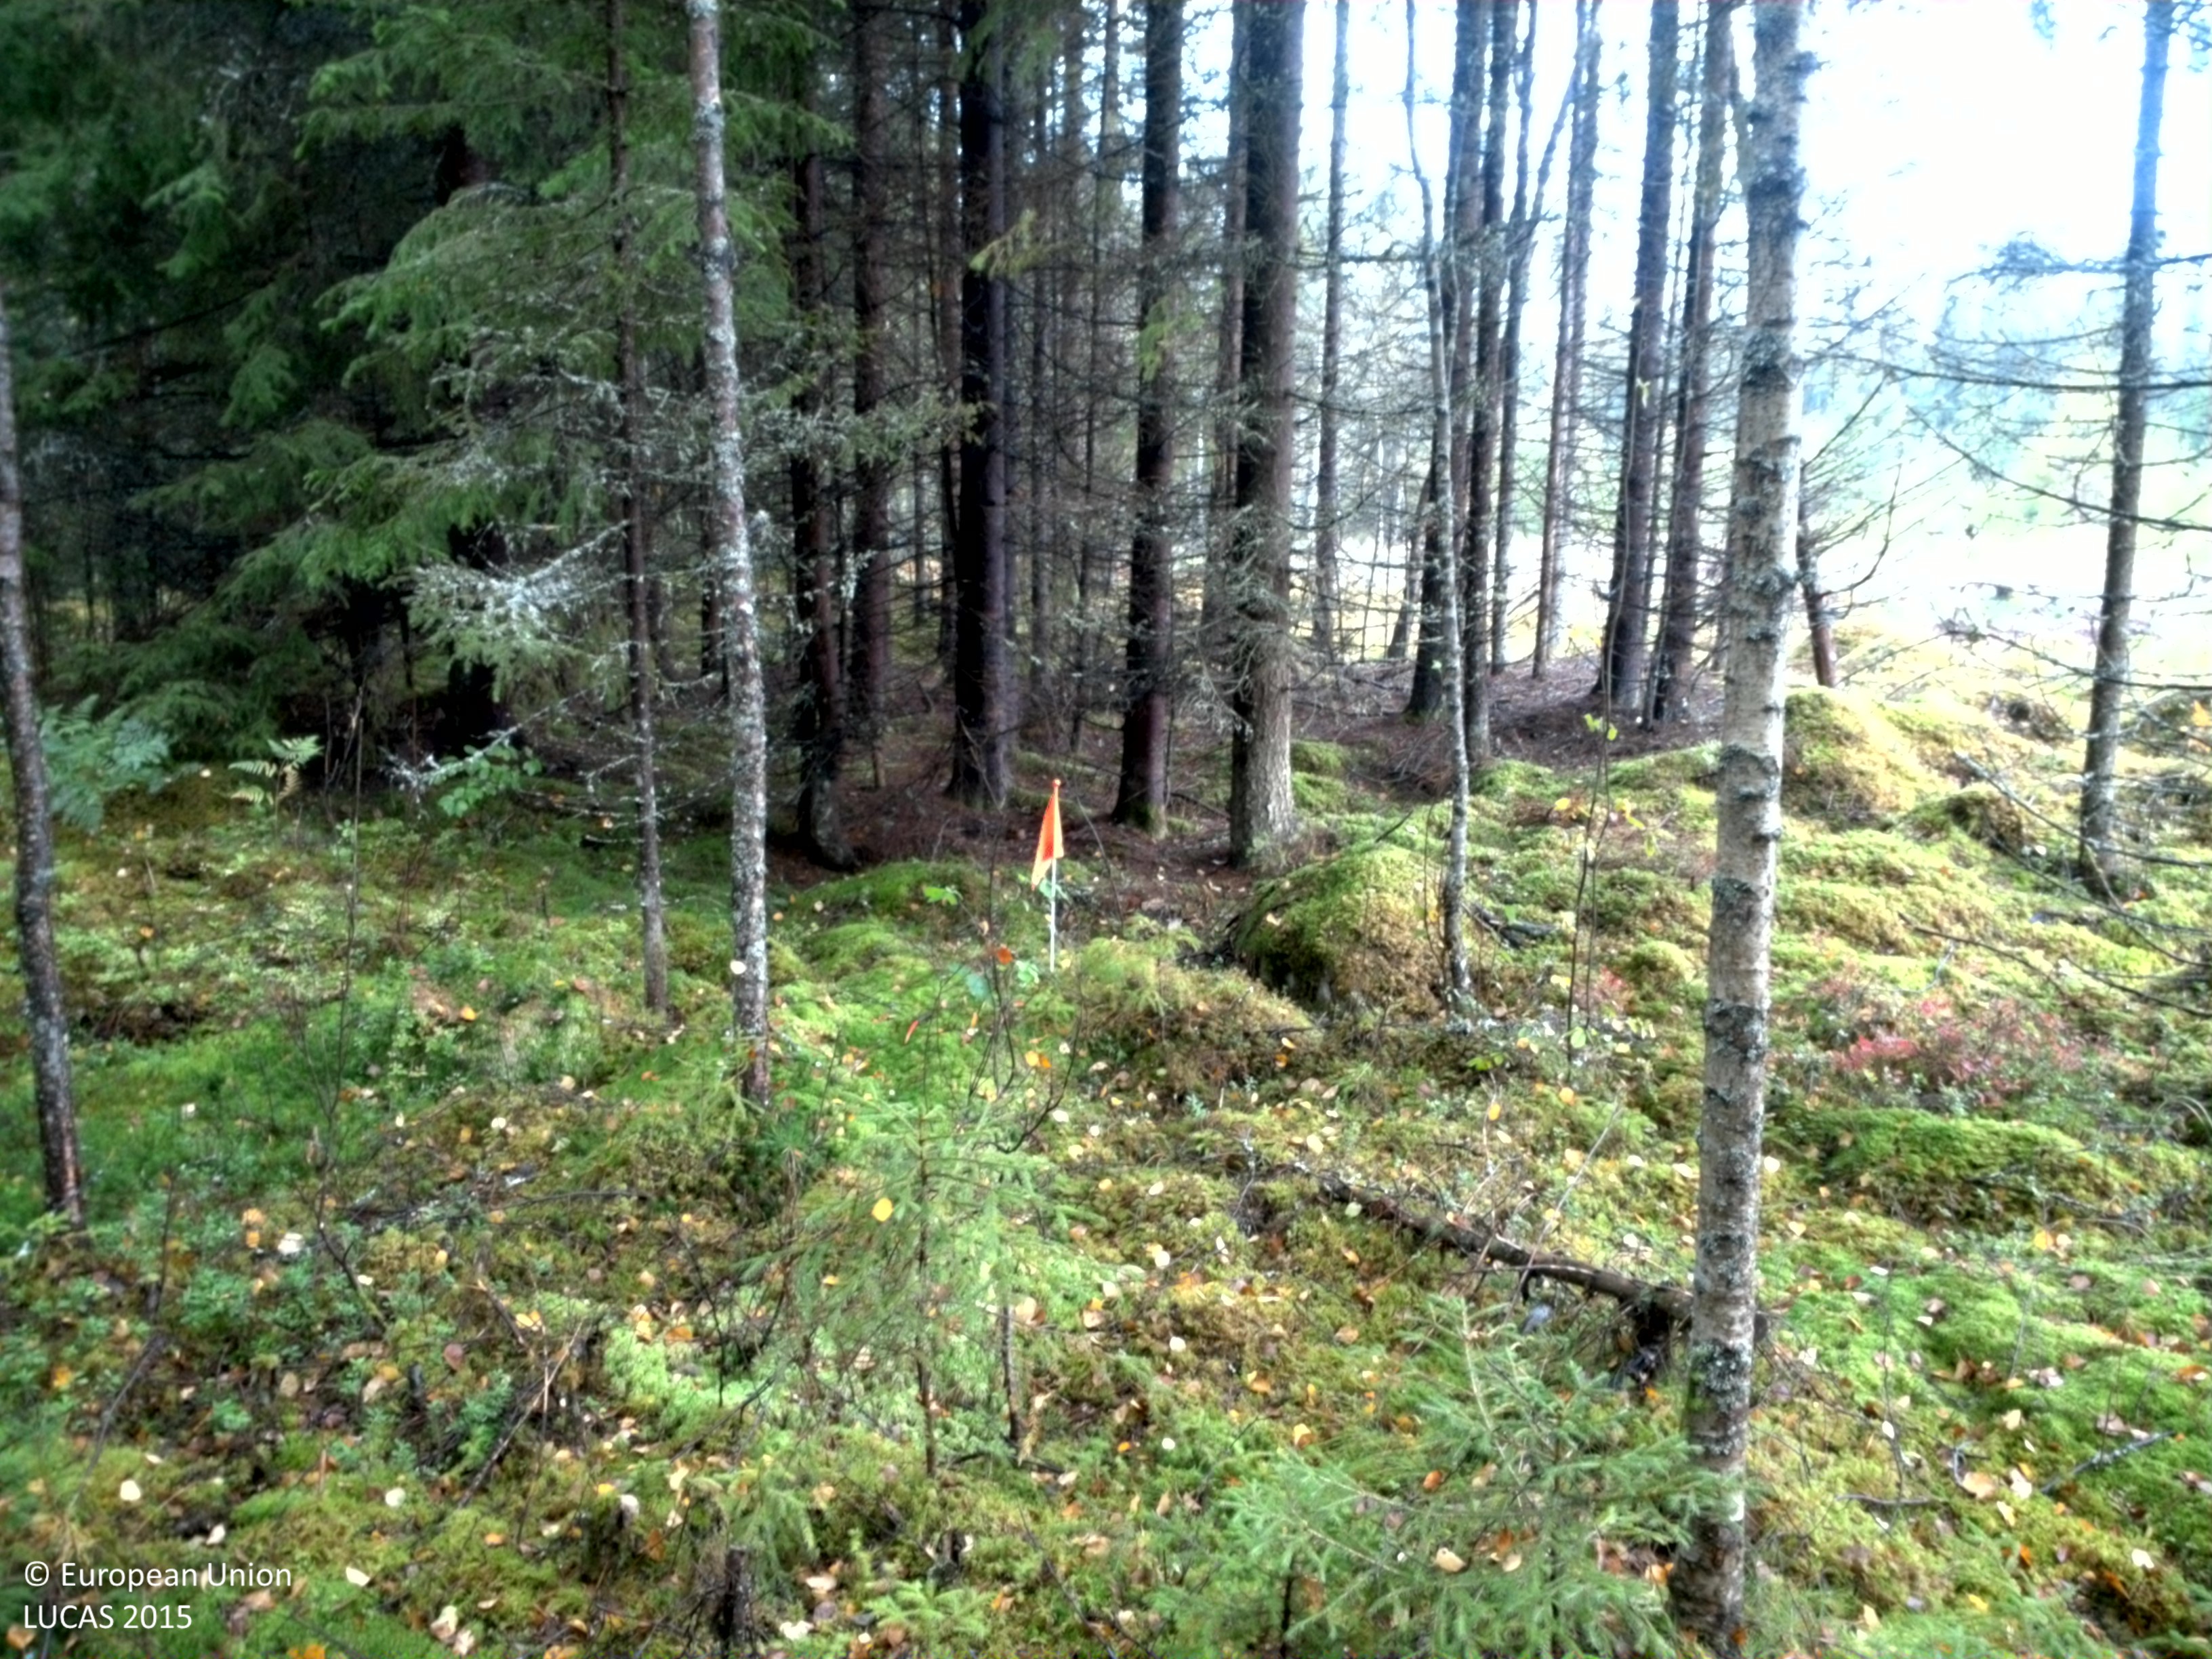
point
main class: Woodland
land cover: Spruce dominated mixed woodland
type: boreal forest
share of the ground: 50 - 75 %
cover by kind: coniferous forest trees 30 %, broadleaved forest trees 20 %, shrubs 20 %, lichens and mosses 20 %, herbaceous plants 10 %
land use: Forestry
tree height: > 5 m
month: September
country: SE
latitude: 58.9693
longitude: 14.0448
